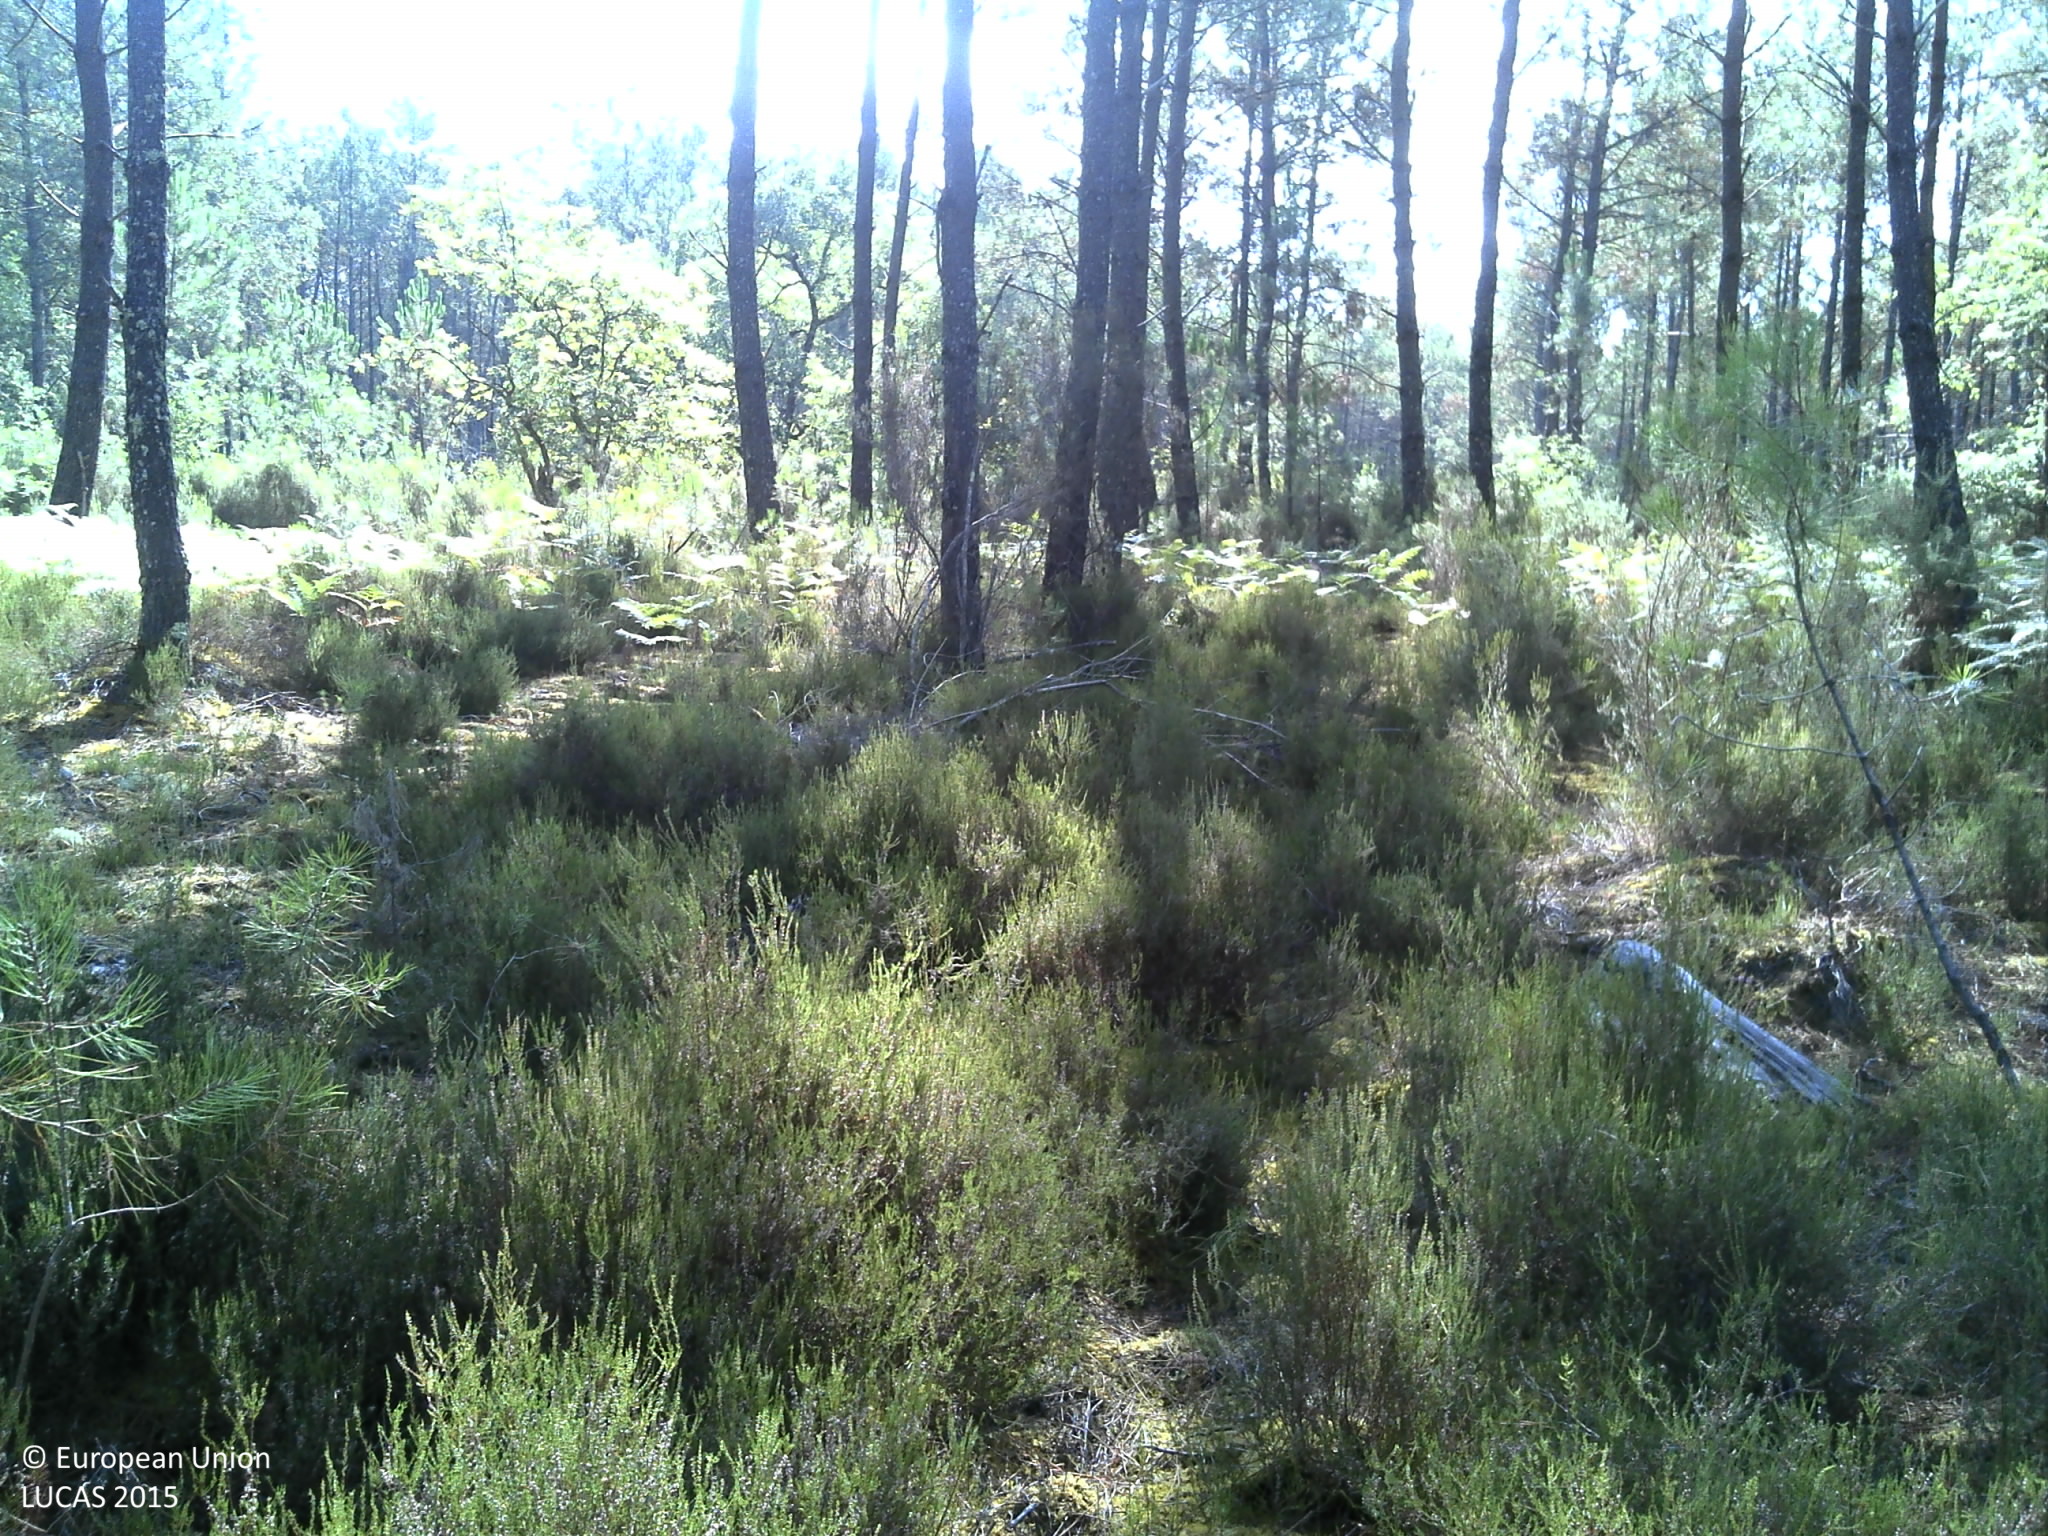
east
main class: Woodland
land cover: Pine dominated coniferous woodland
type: coniferous forest of the mediterranean region
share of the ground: > 75 %
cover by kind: coniferous forest trees 60 %, shrubs 30 %, herbaceous plants 5 %, lichens and mosses 5 %
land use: Forestry
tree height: > 5 m
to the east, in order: Pine dominated coniferous woodland; Shruby margins; Ditches and canals; Shruby margins; Pine dominated coniferous woodland
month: July
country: FR
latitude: 44.4032
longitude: -0.4489
